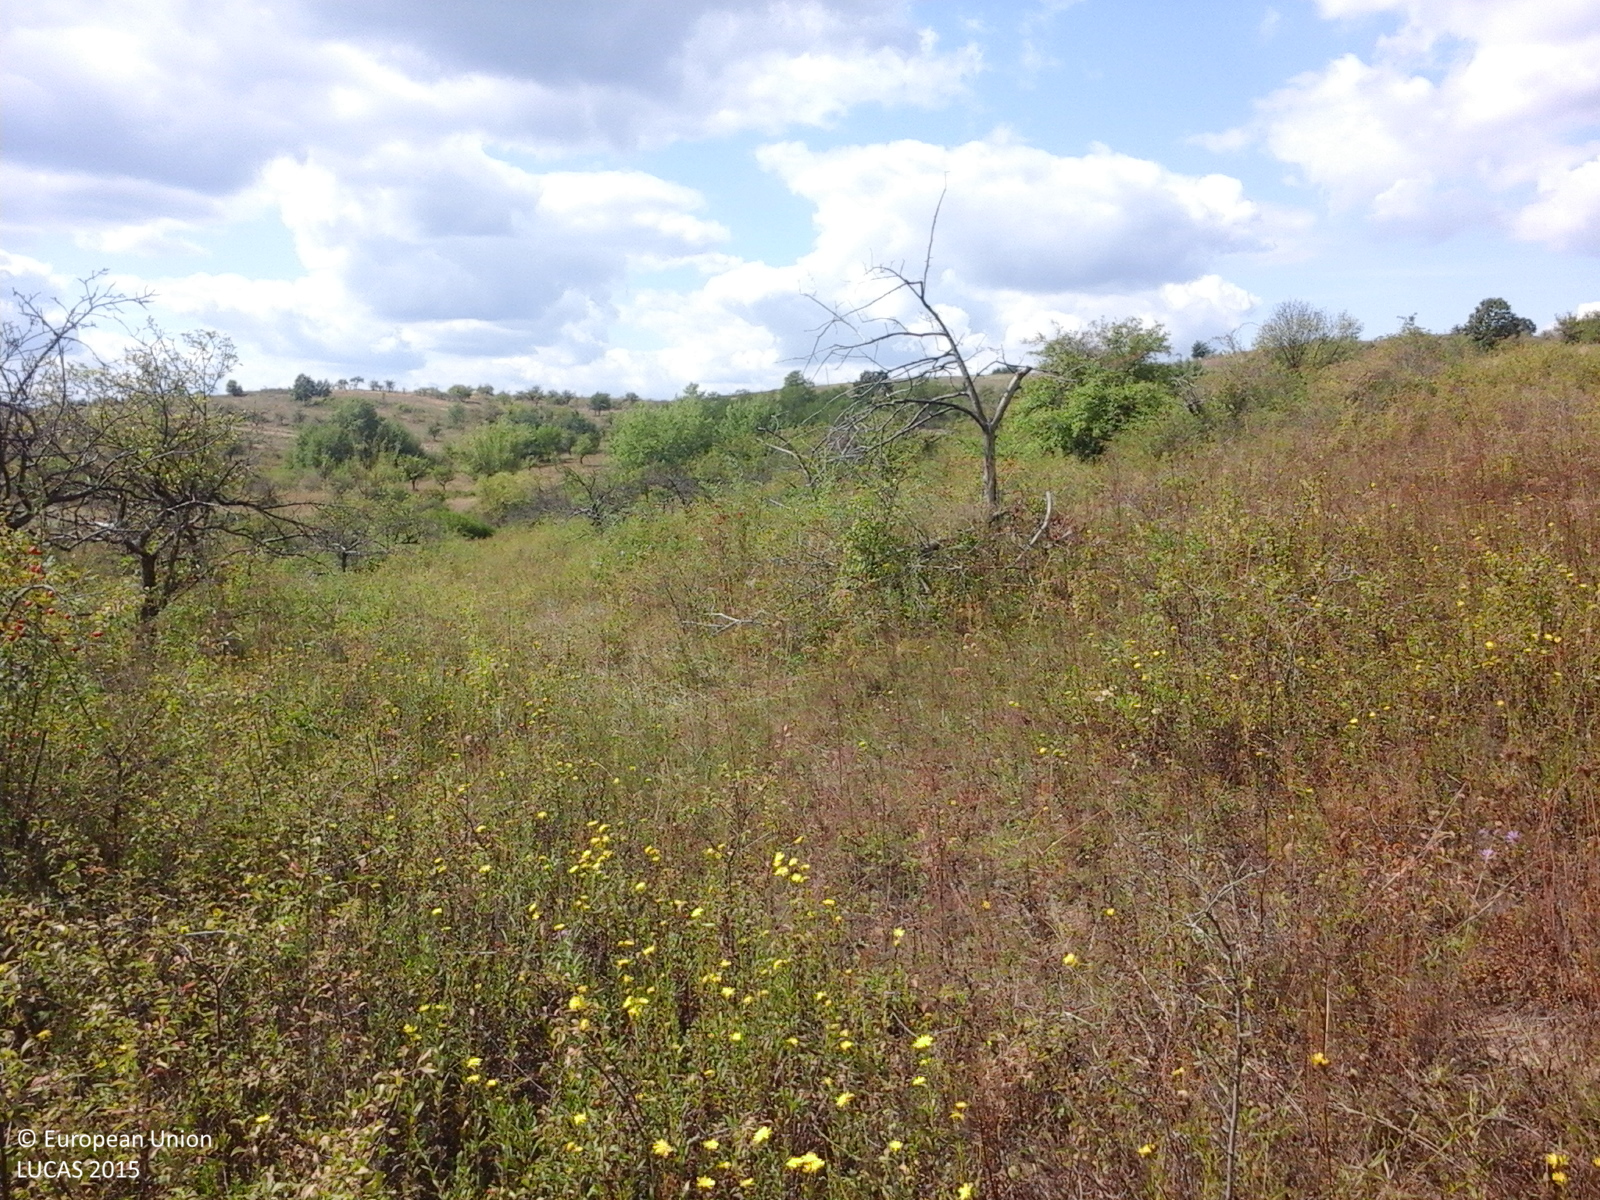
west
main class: Grassland
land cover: Spontaneously vegetated surfaces
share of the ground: > 75 %
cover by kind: herbaceous plants 100 %
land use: Fallow land
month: September
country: RO
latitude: 47.4585
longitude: 23.0789
